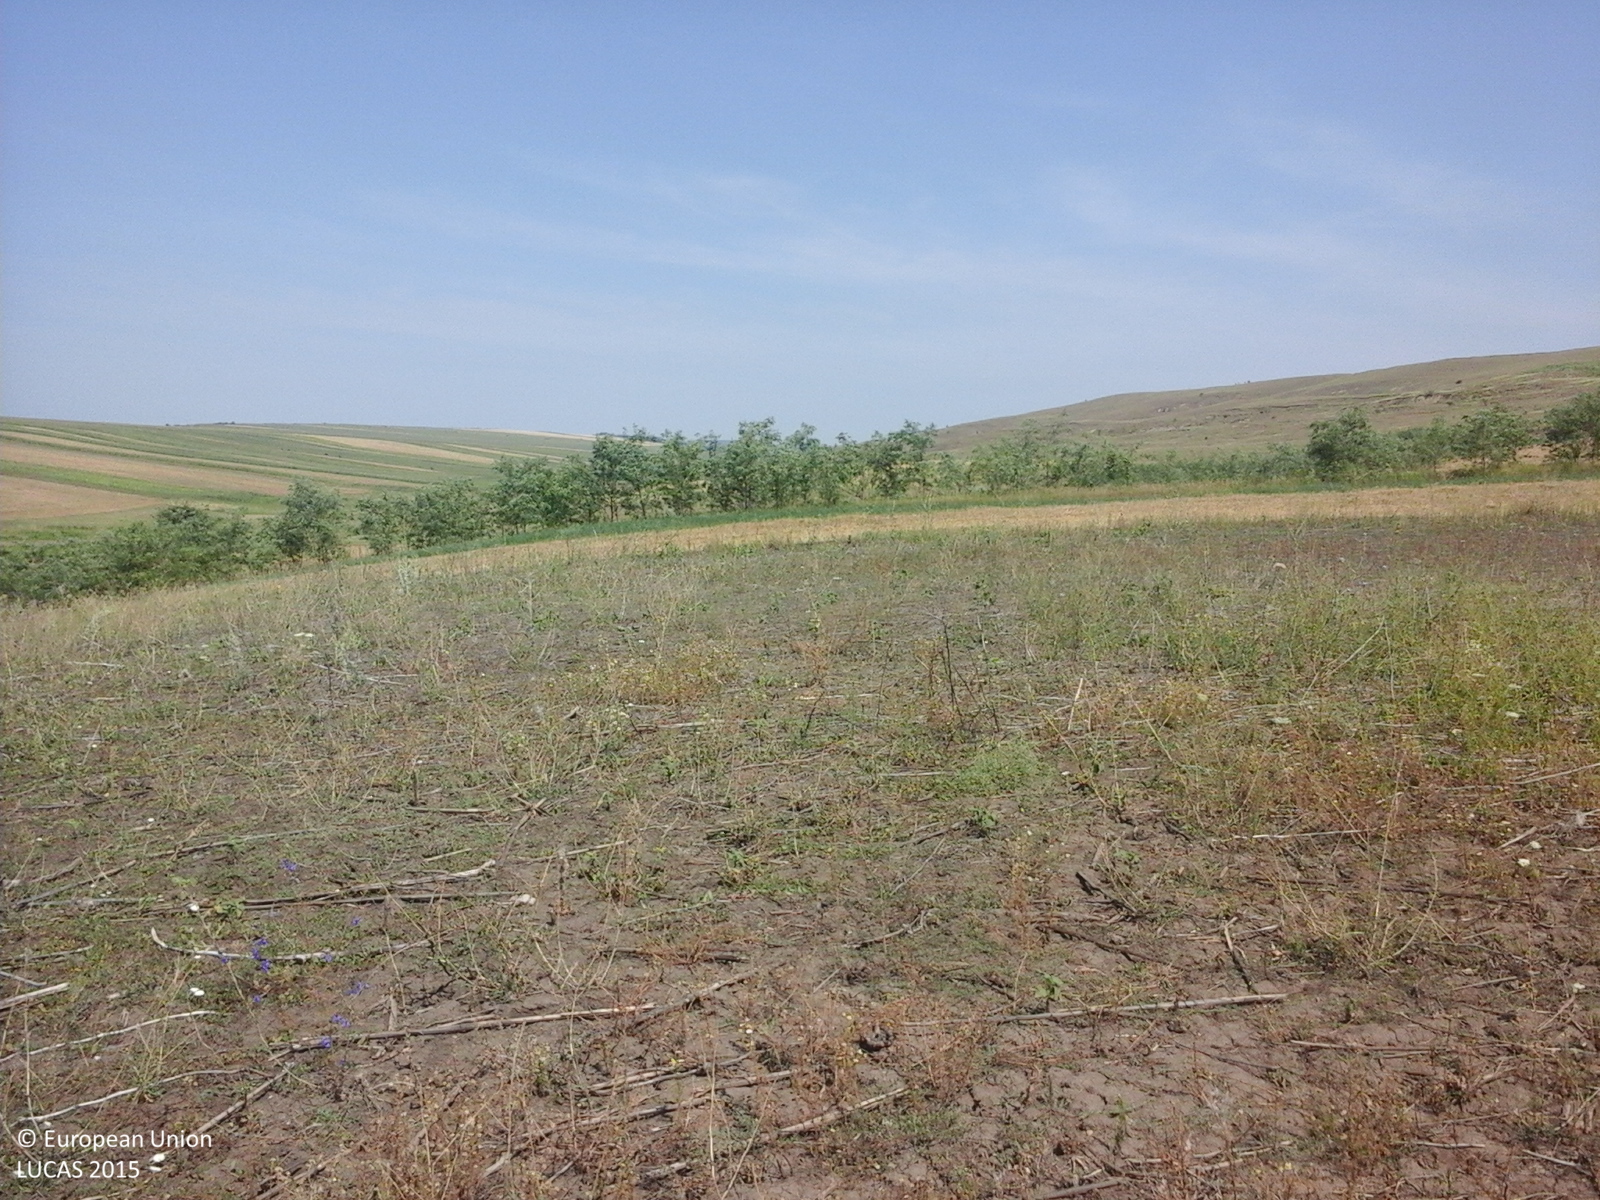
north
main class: Grassland
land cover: Spontaneously vegetated surfaces
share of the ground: 25 - 50 %
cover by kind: herbaceous plants 100 %
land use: Fallow land
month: July
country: RO
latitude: 46.2278
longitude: 27.2282
